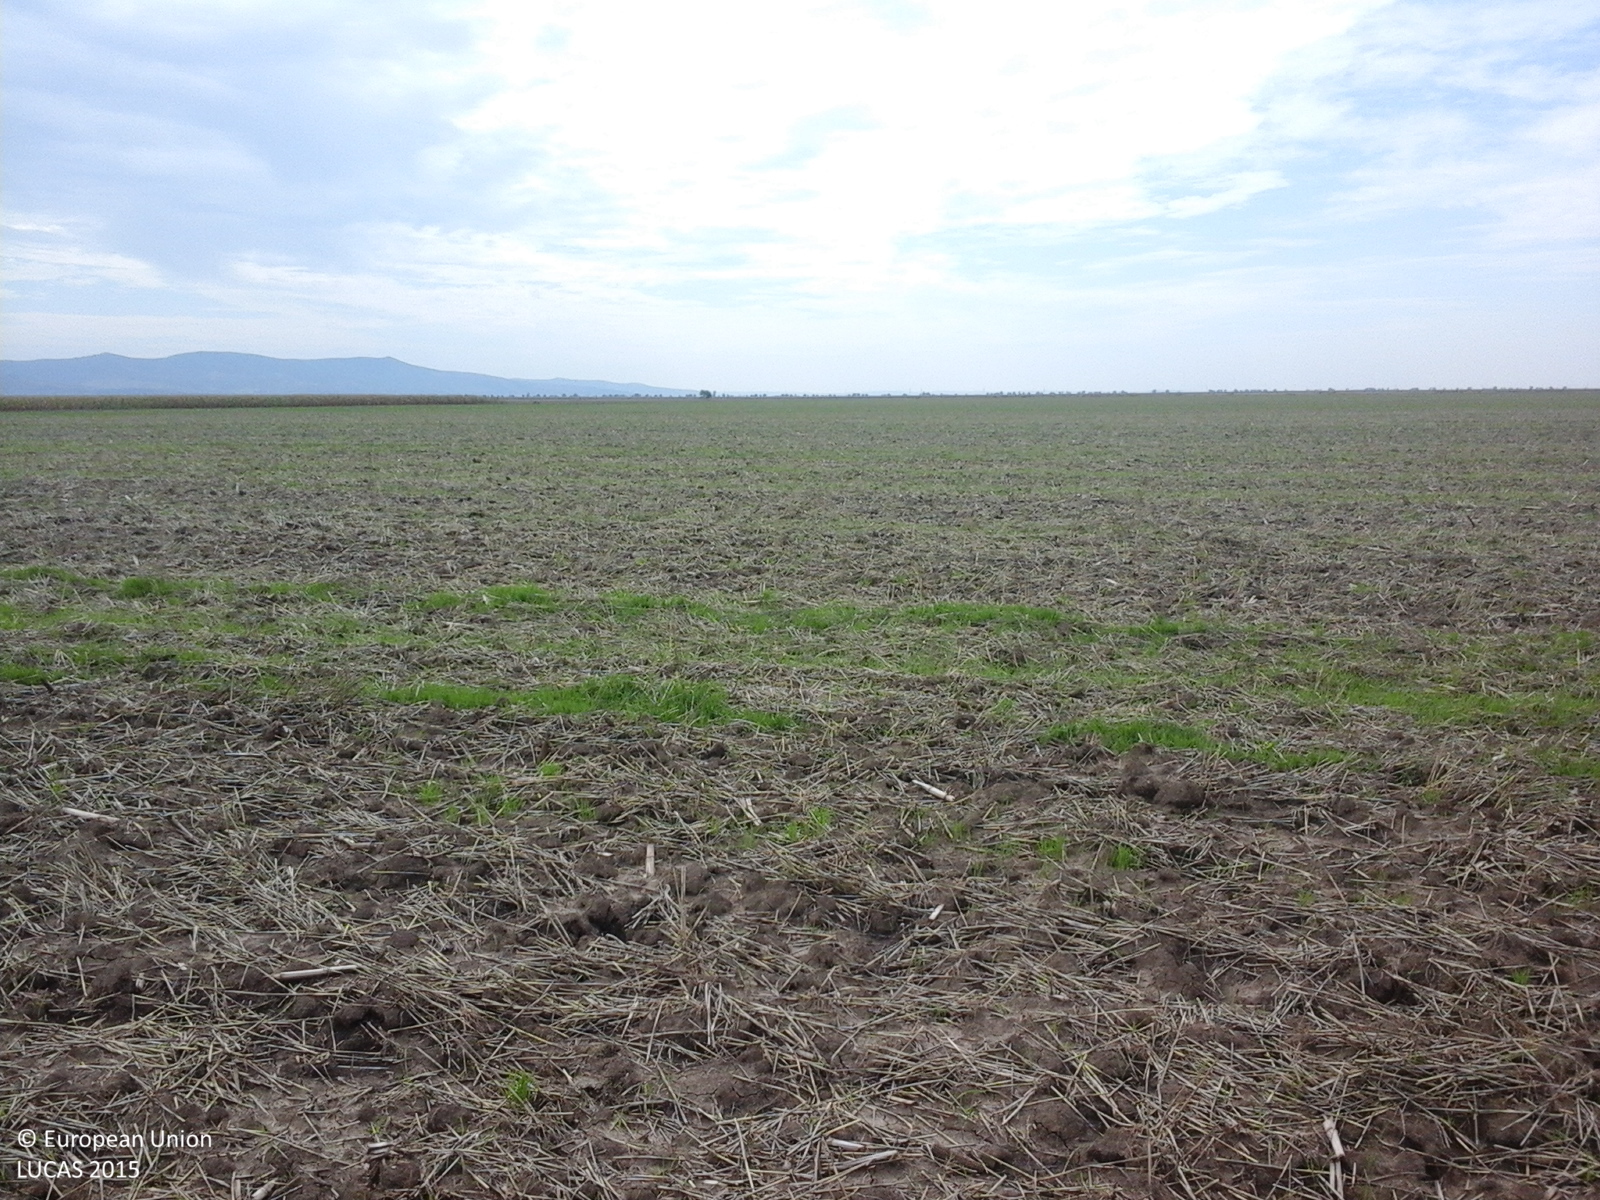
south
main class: Cropland
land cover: Common wheat
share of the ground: 25 - 50 %
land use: Agriculture (excluding fallow land and kitchen gardens)
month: August
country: RO
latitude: 46.2870
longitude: 21.5503
